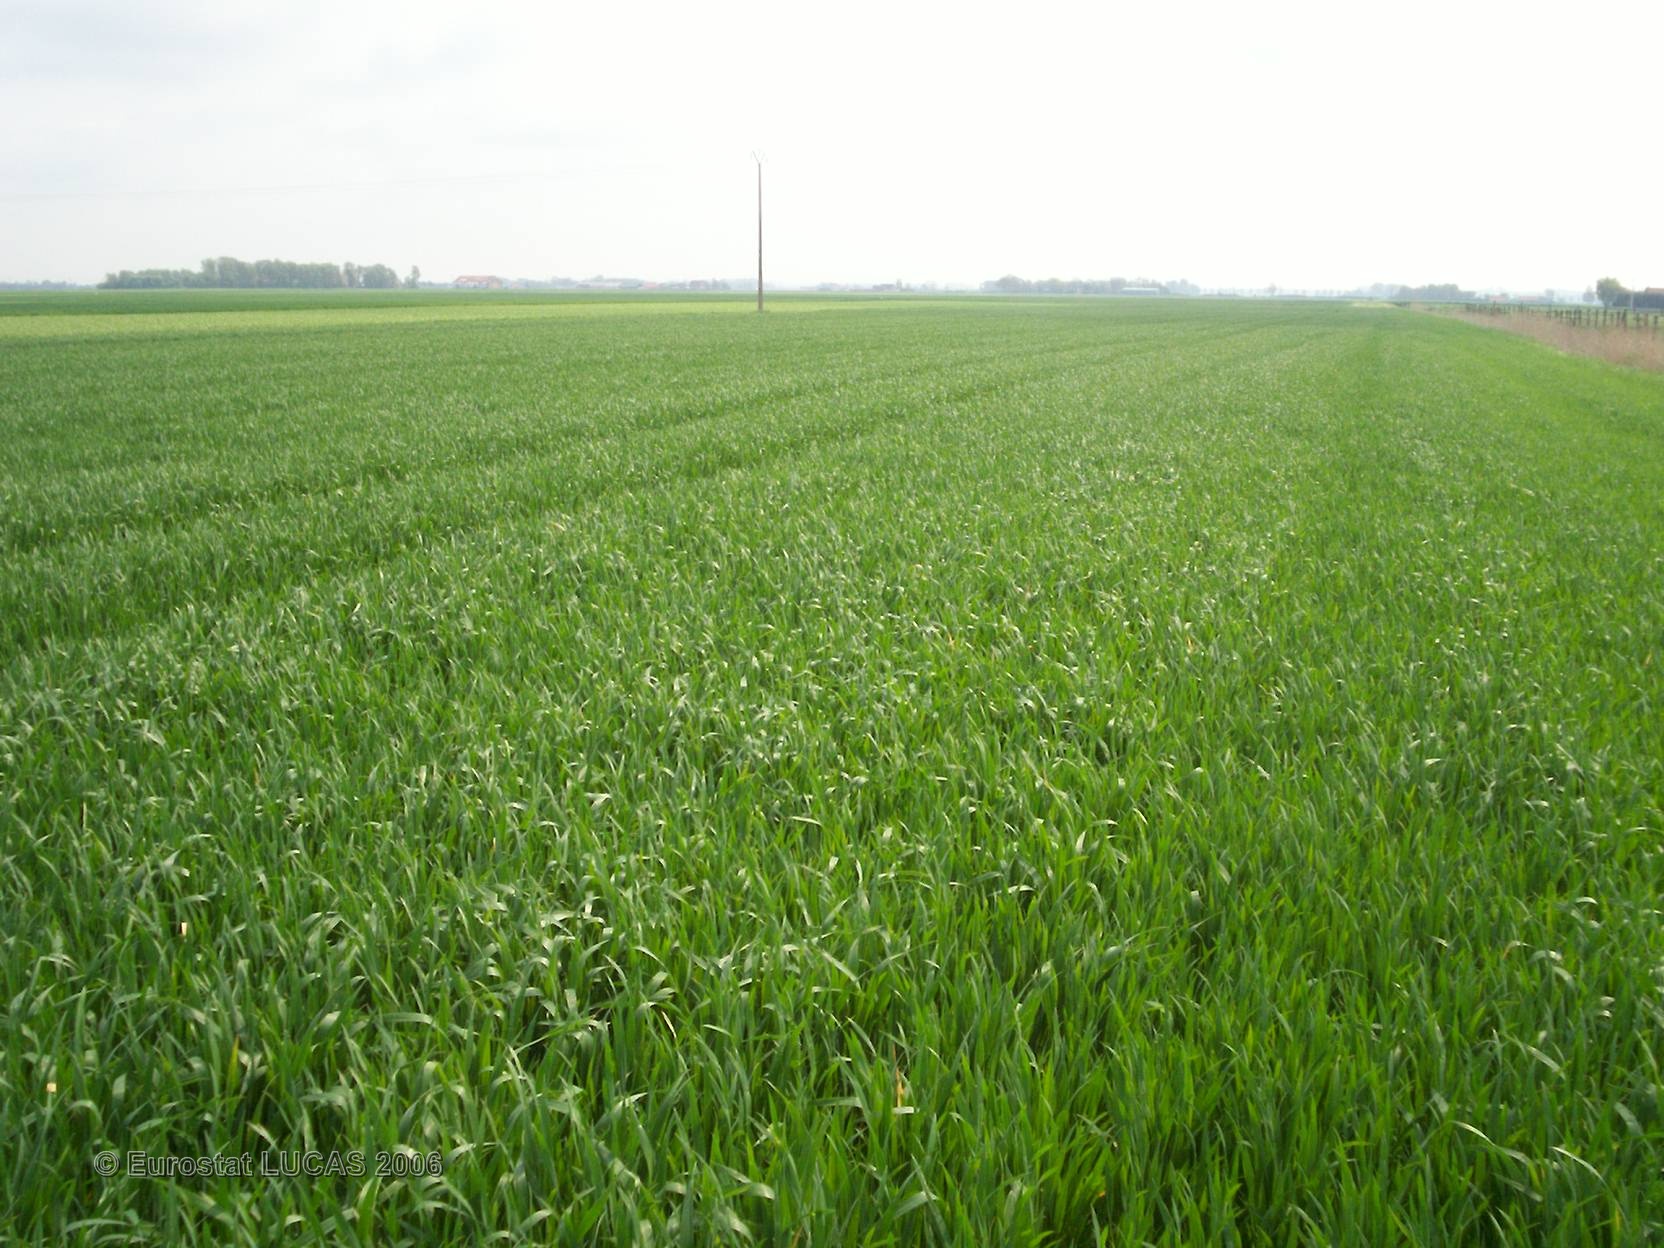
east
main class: Cropland
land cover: Common wheat
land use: Agriculture (excluding fallow land and kitchen gardens)
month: May
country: FR
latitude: 50.9701
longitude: 2.2818
